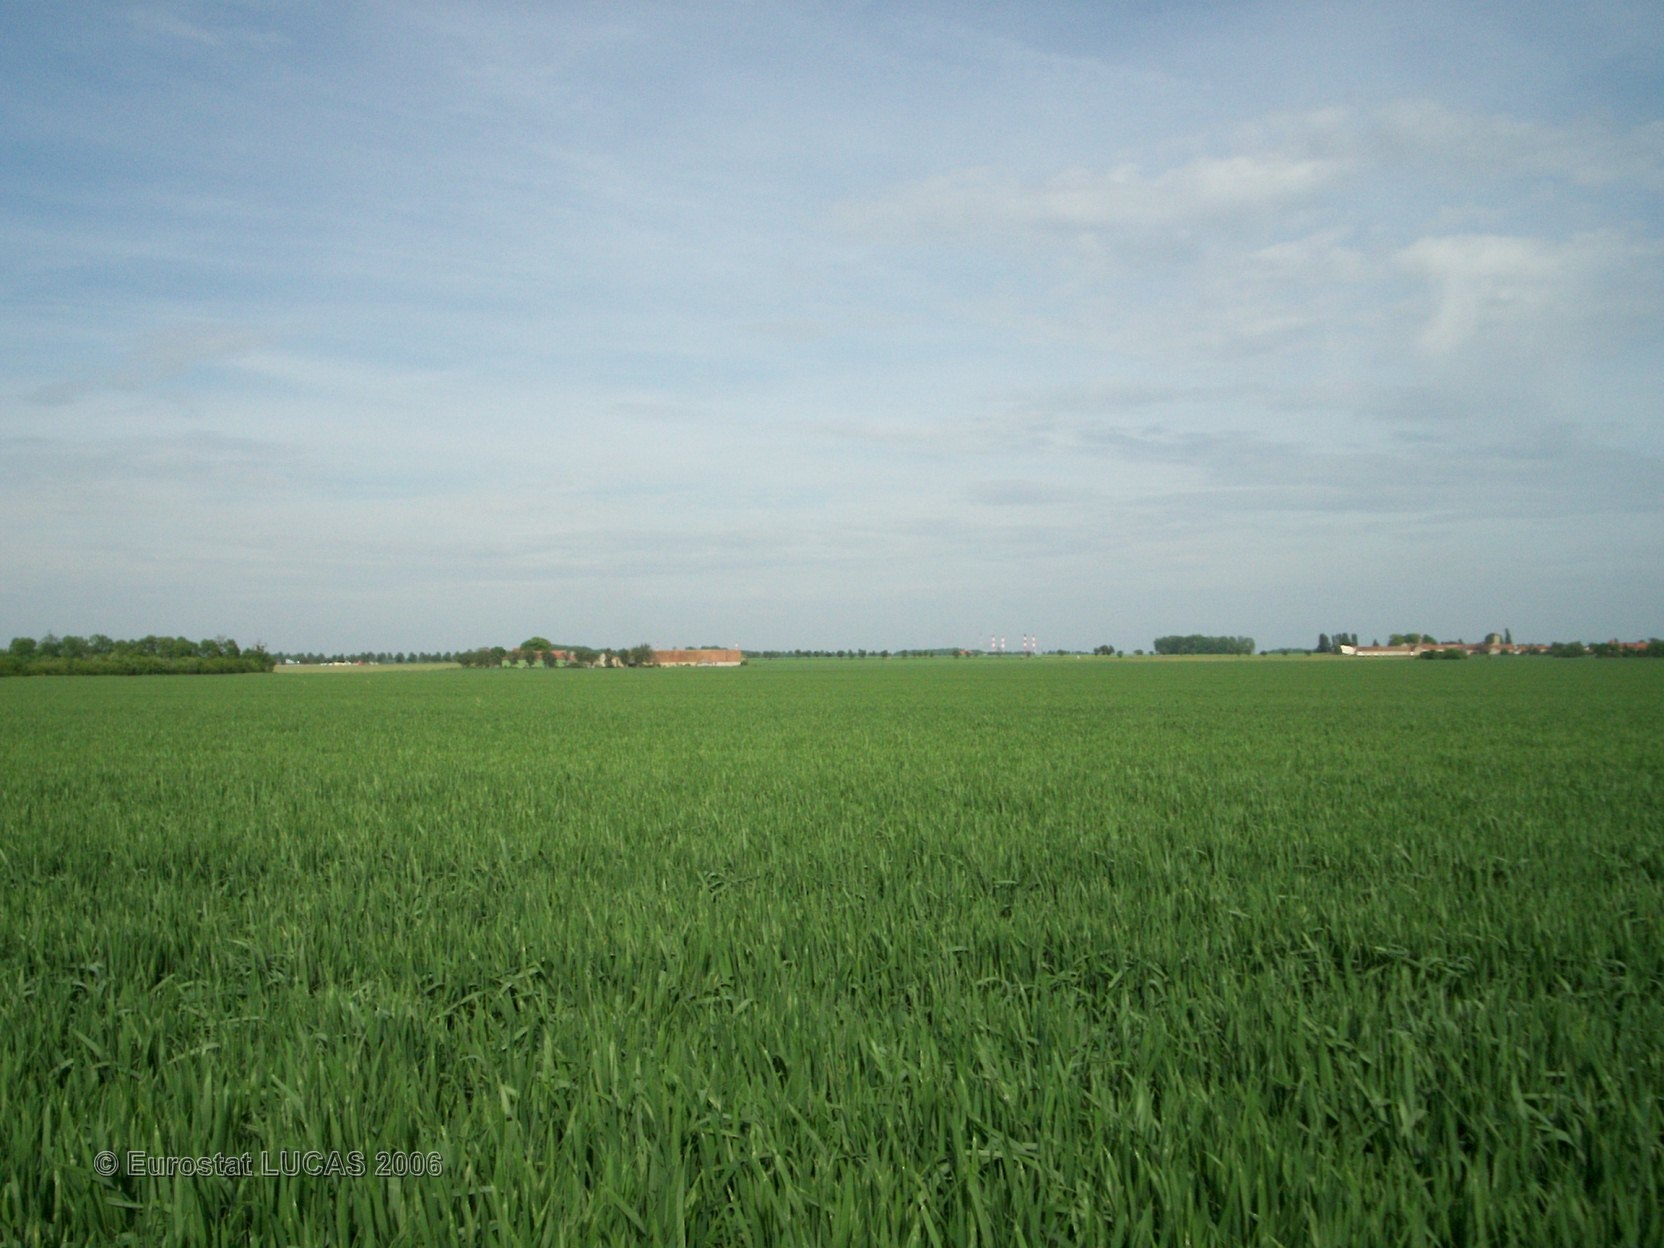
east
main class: Cropland
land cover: Common wheat
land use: Agriculture (excluding fallow land and kitchen gardens)
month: May
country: FR
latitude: 48.5888
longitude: 2.8735
